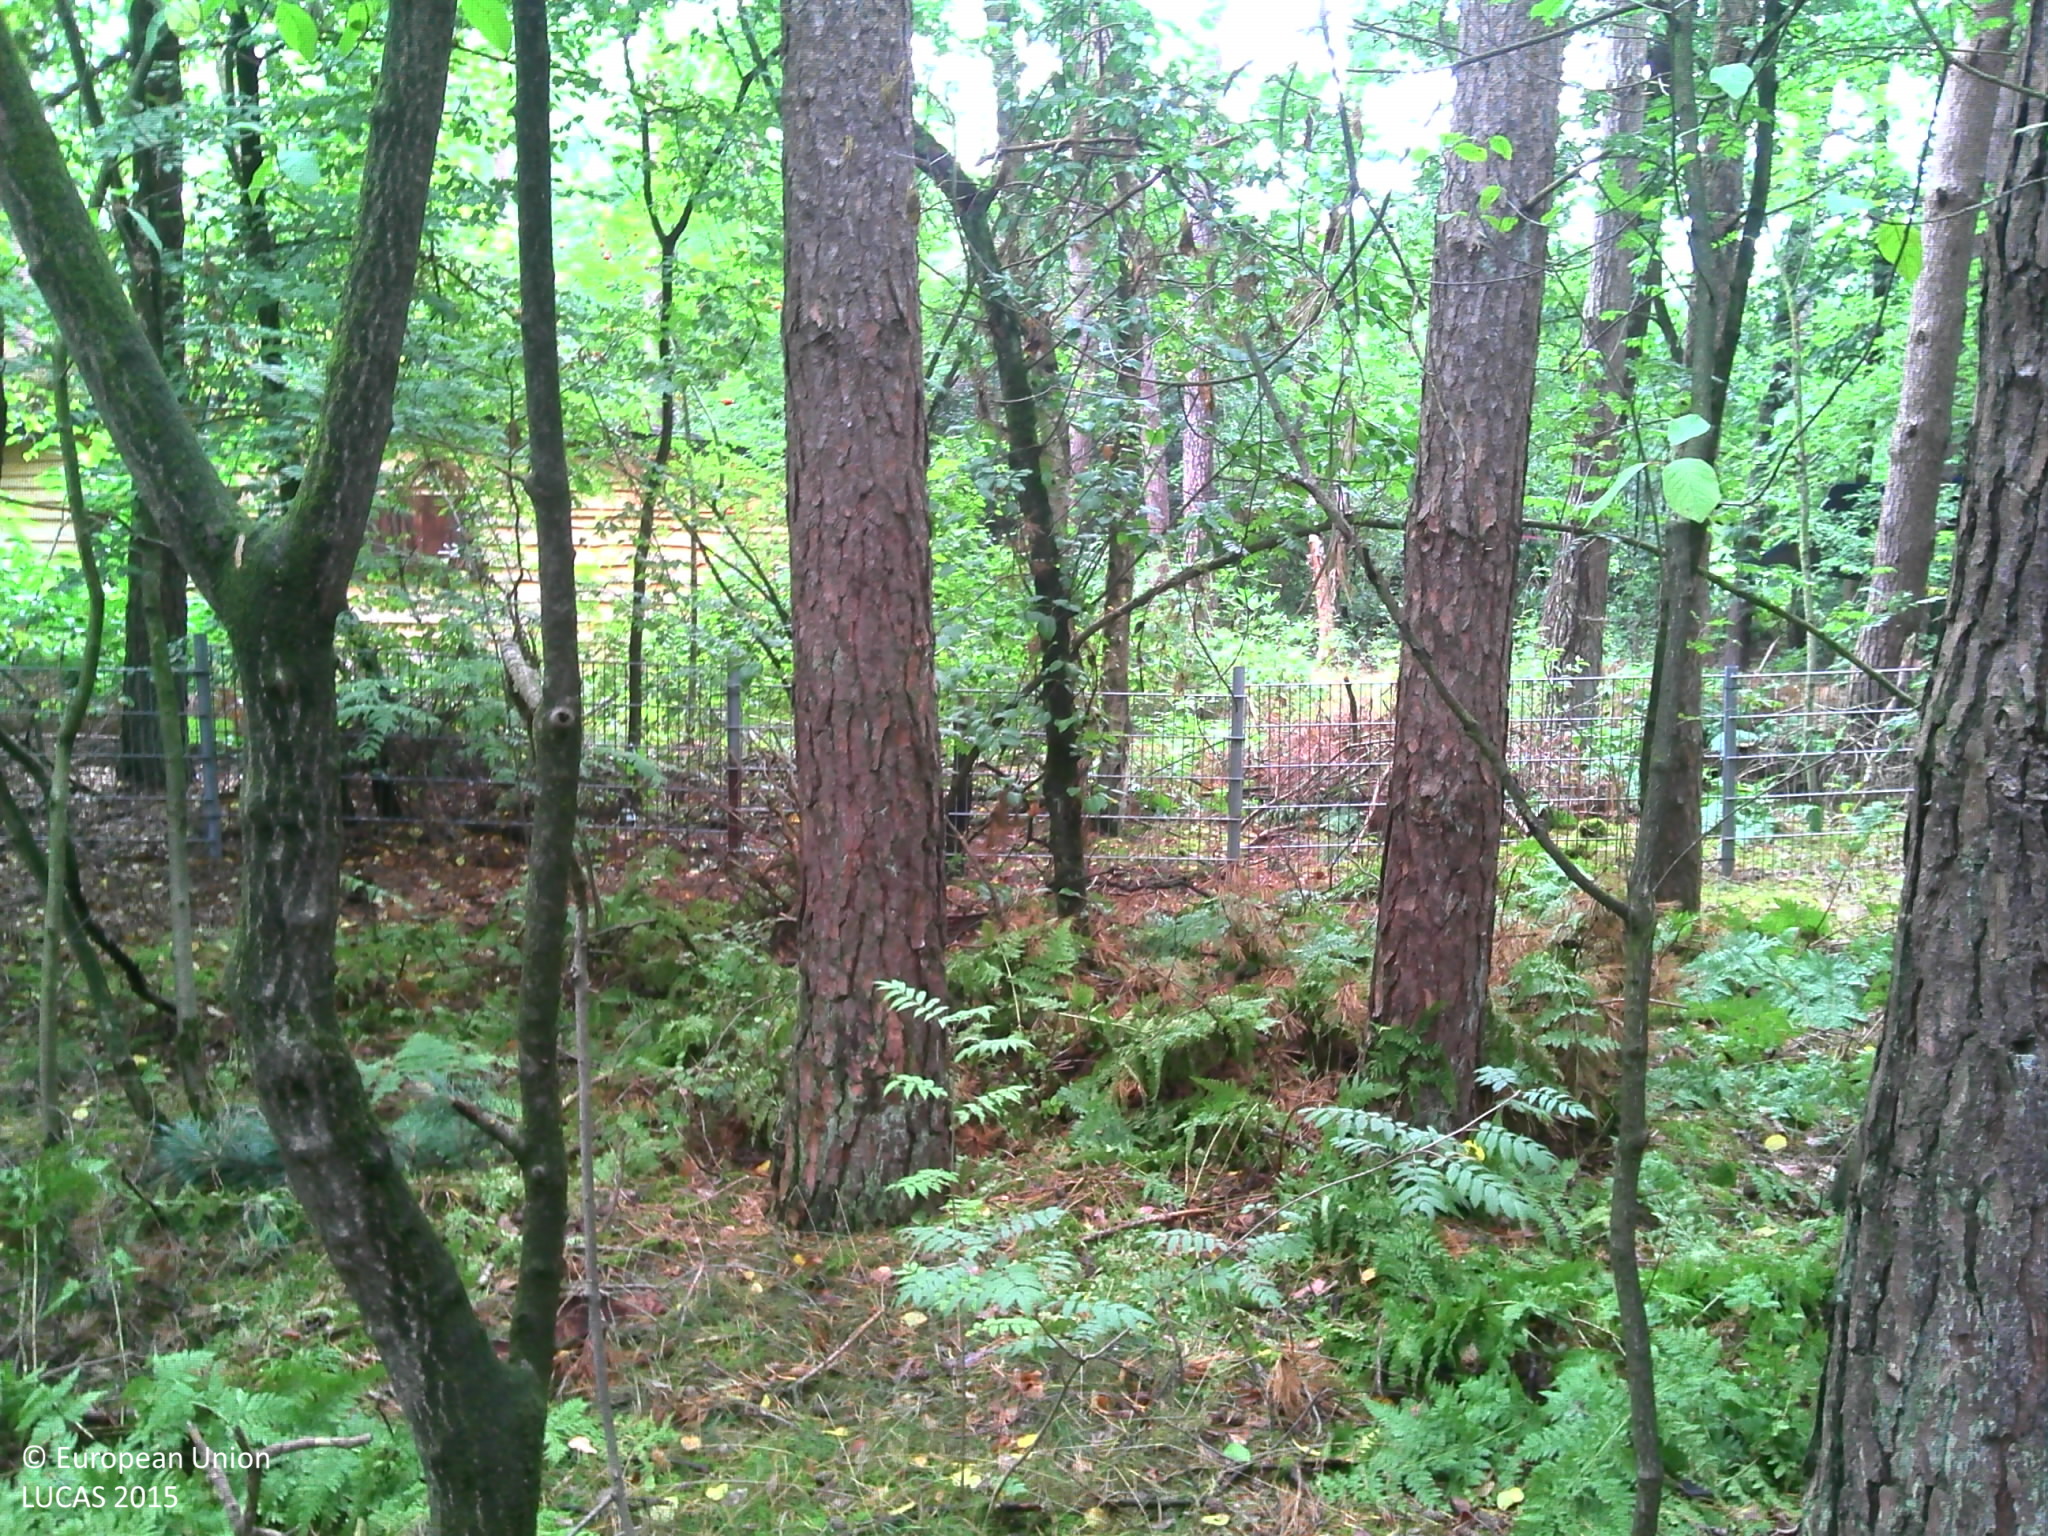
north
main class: Woodland
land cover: Pine dominated coniferous woodland
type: exotic forest
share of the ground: > 75 %
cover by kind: coniferous forest trees 90 %, broadleaved forest trees 5 %, shrubs 5 %
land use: Forestry
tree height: > 5 m
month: August
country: BE
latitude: 51.2813
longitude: 4.9935
